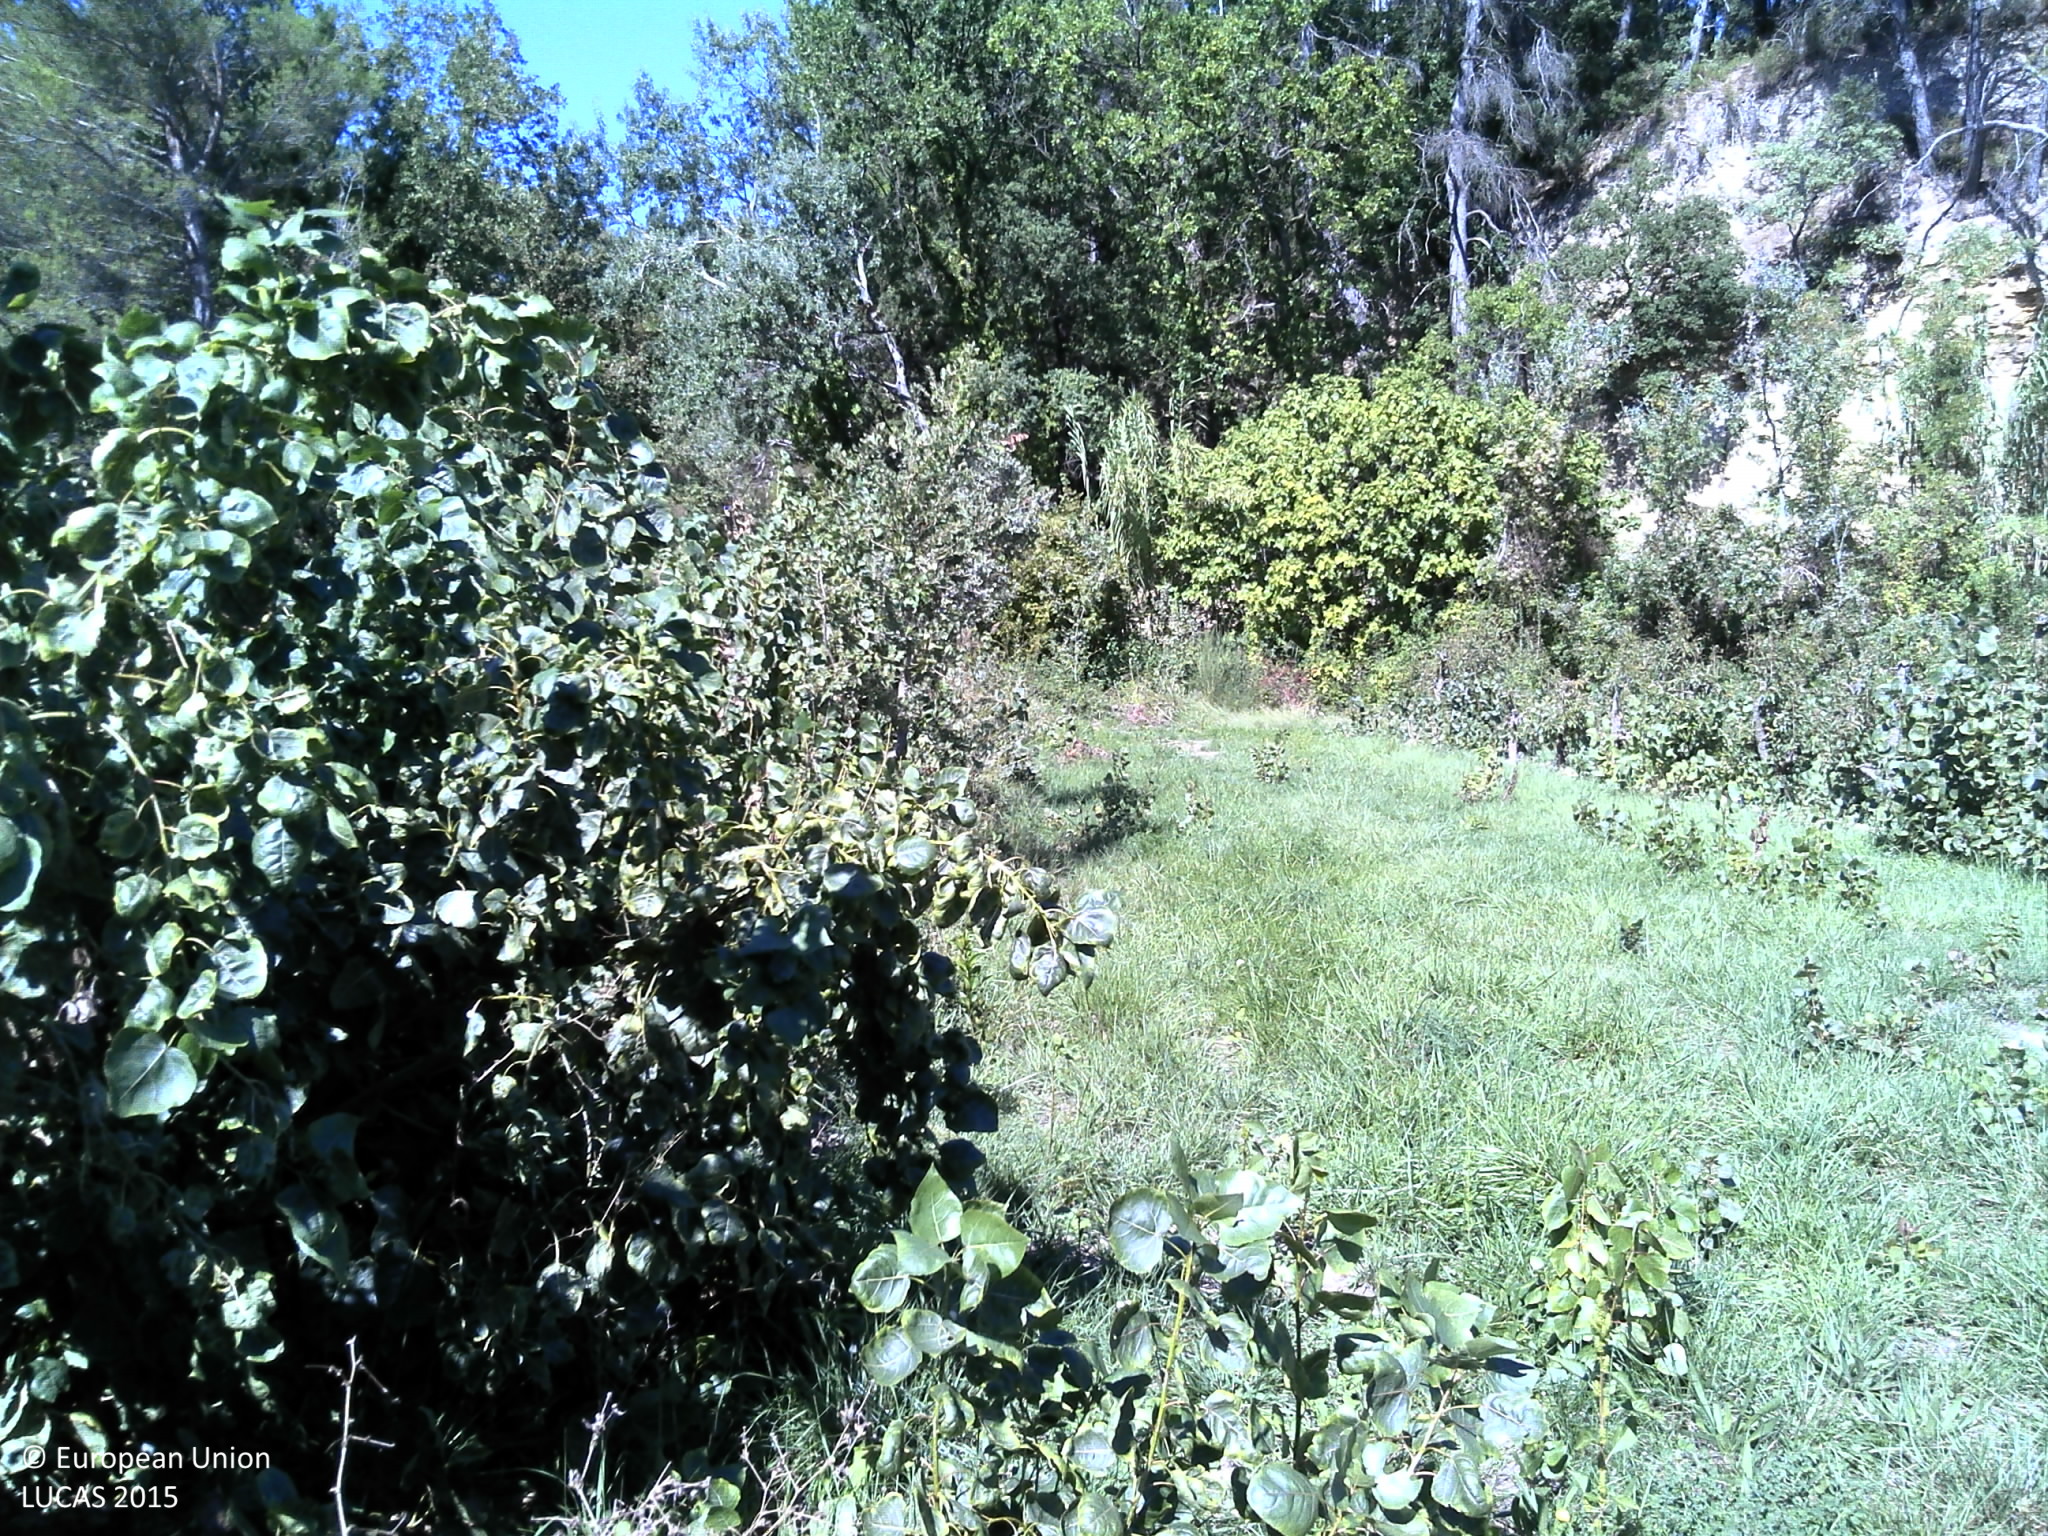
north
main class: Cropland
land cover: Pear fruit
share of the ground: 10 - 25 %
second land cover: Grassland without tree/shrub cover
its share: > 75 %
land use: Agriculture (excluding fallow land and kitchen gardens)
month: September
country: FR
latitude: 43.7541
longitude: 5.2524
